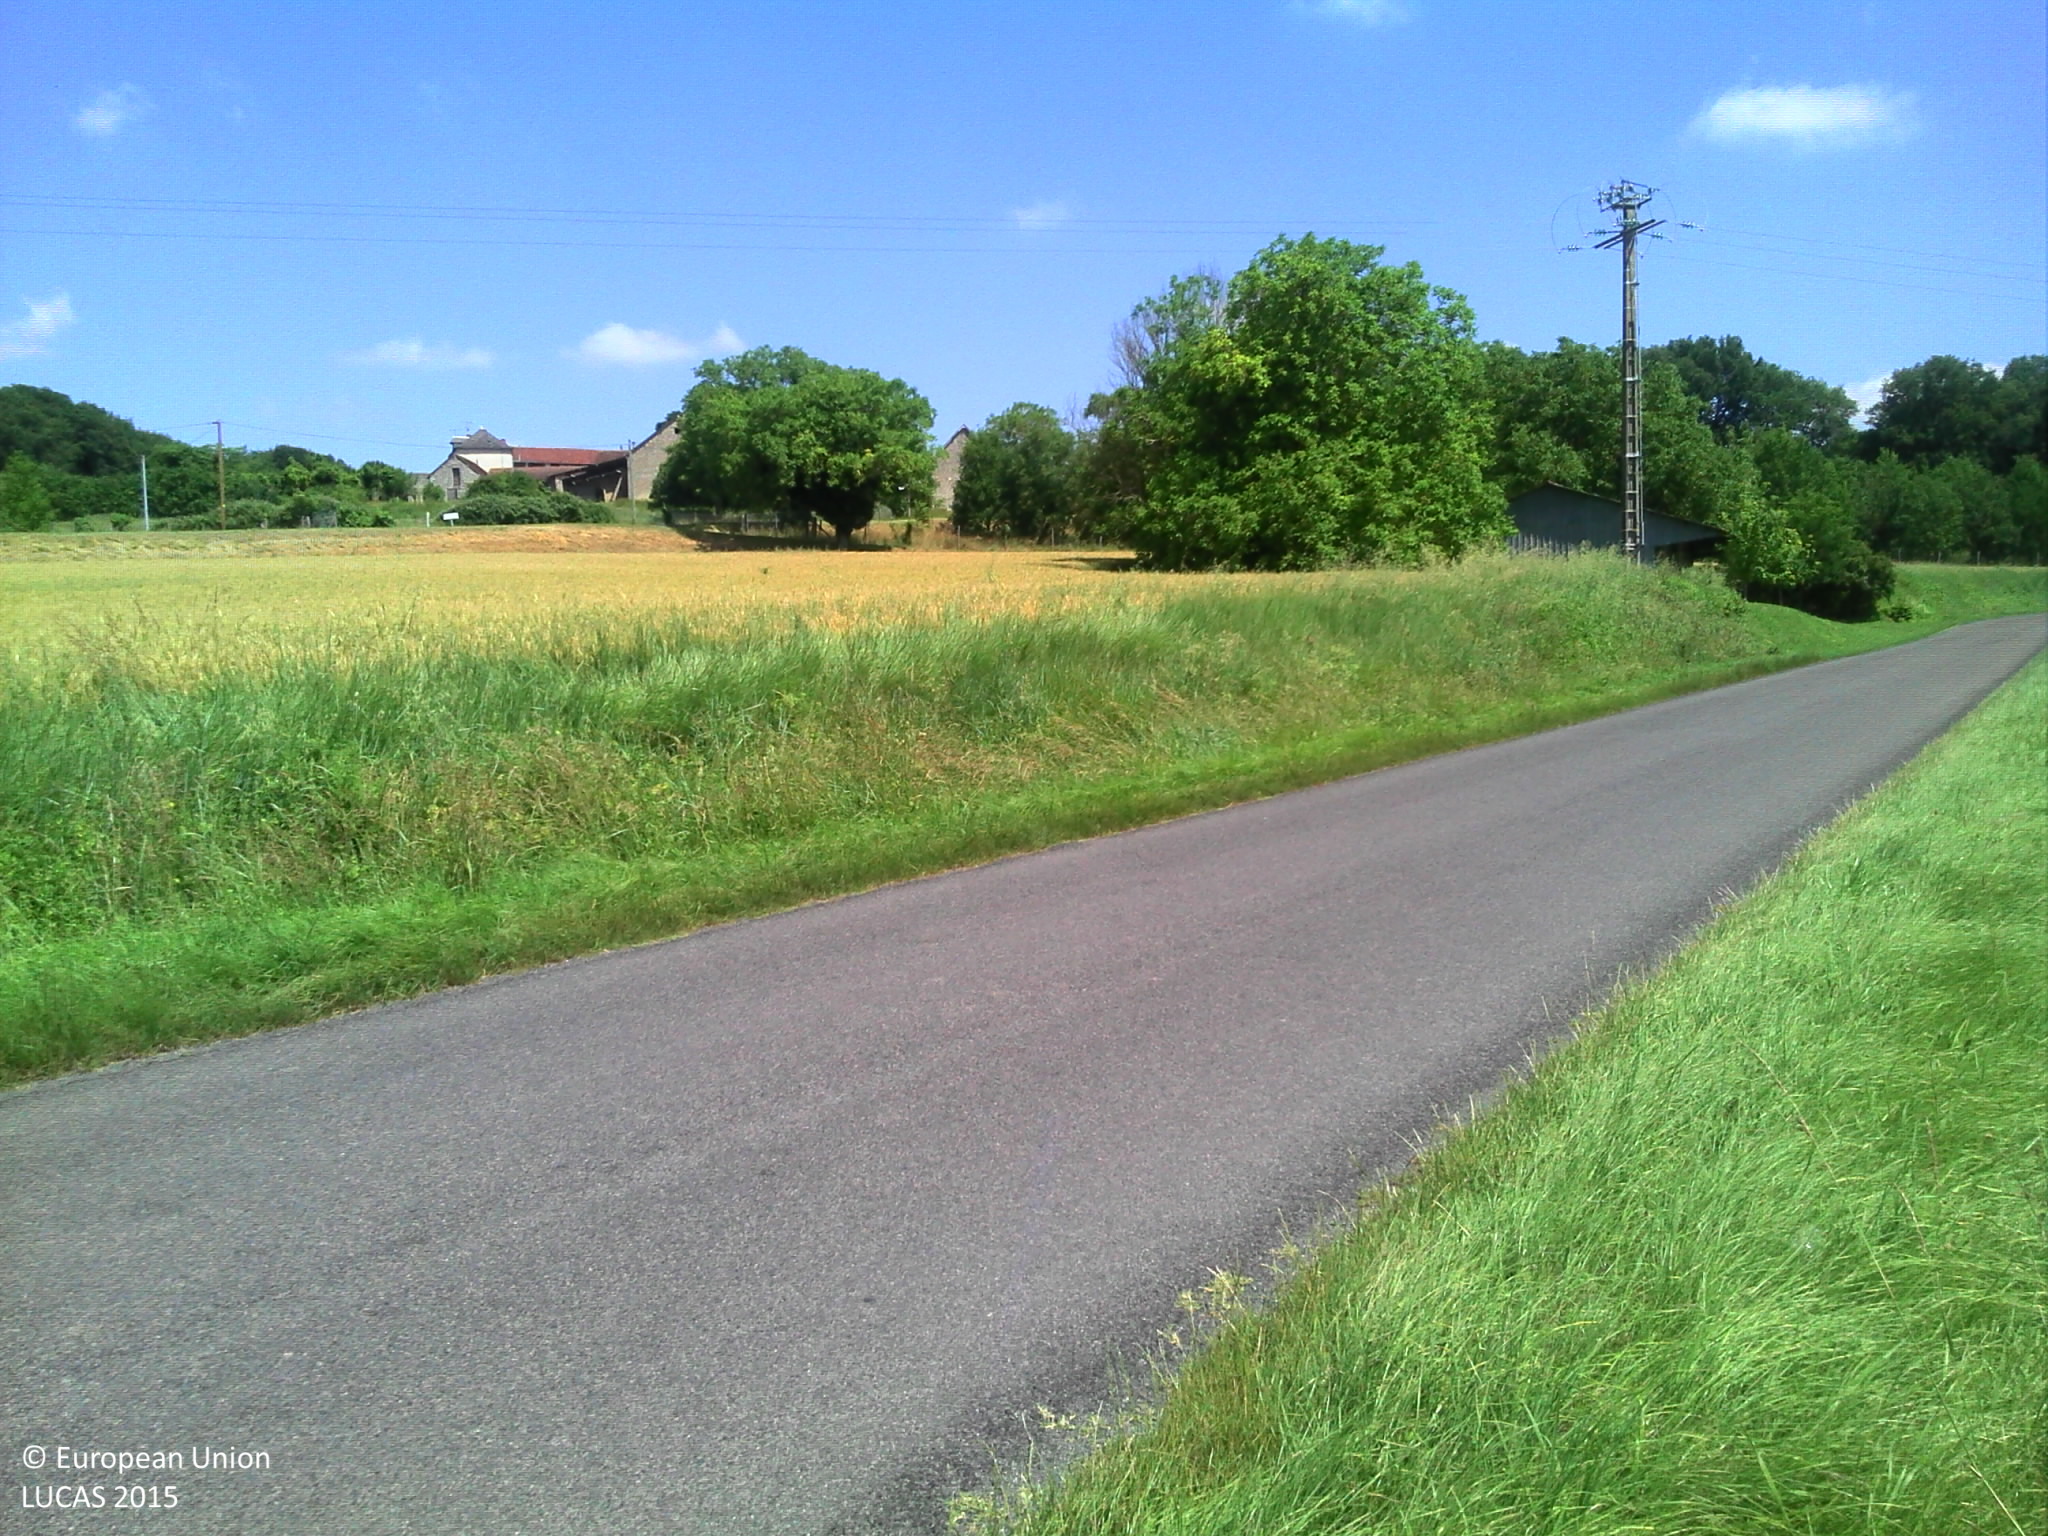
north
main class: Woodland
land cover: Broadleaved woodland
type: exotic forest
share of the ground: 25 - 50 %
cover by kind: herbaceous plants 65 %, broadleaved forest trees 25 %, unconsolidated bare surface 10 %
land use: Forestry
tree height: < 5 m
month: June
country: FR
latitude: 46.9457
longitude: 0.5349
